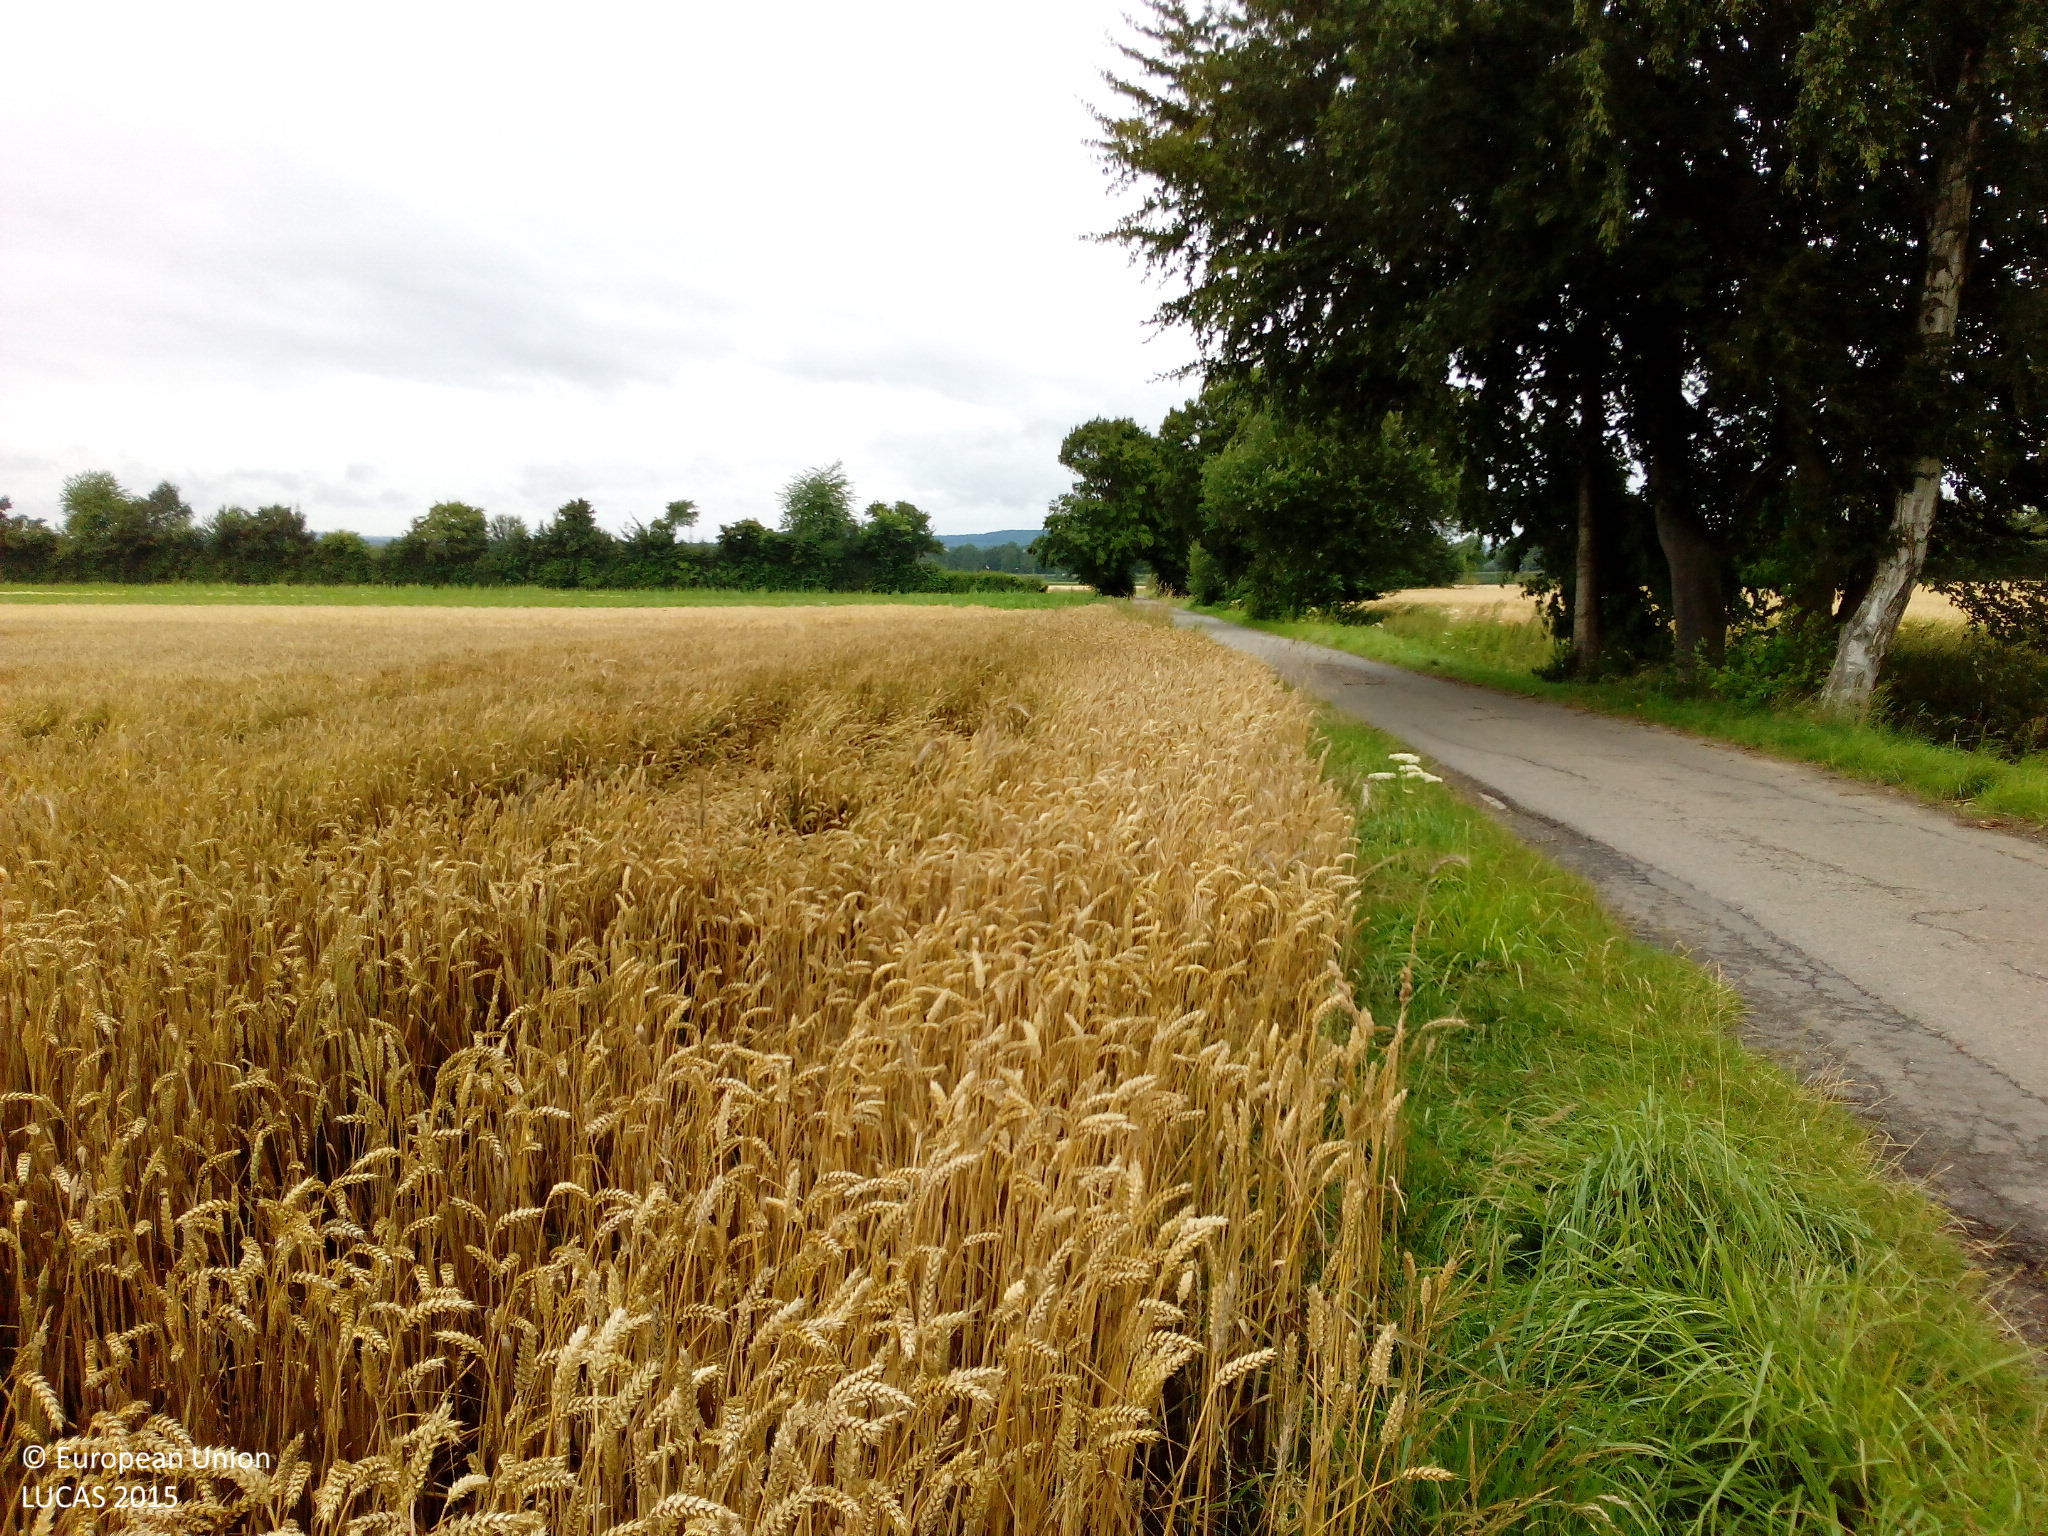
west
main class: Cropland
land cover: Common wheat
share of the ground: > 75 %
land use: Agriculture (excluding fallow land and kitchen gardens)
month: July
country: DE
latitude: 51.5116
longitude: 9.1501
